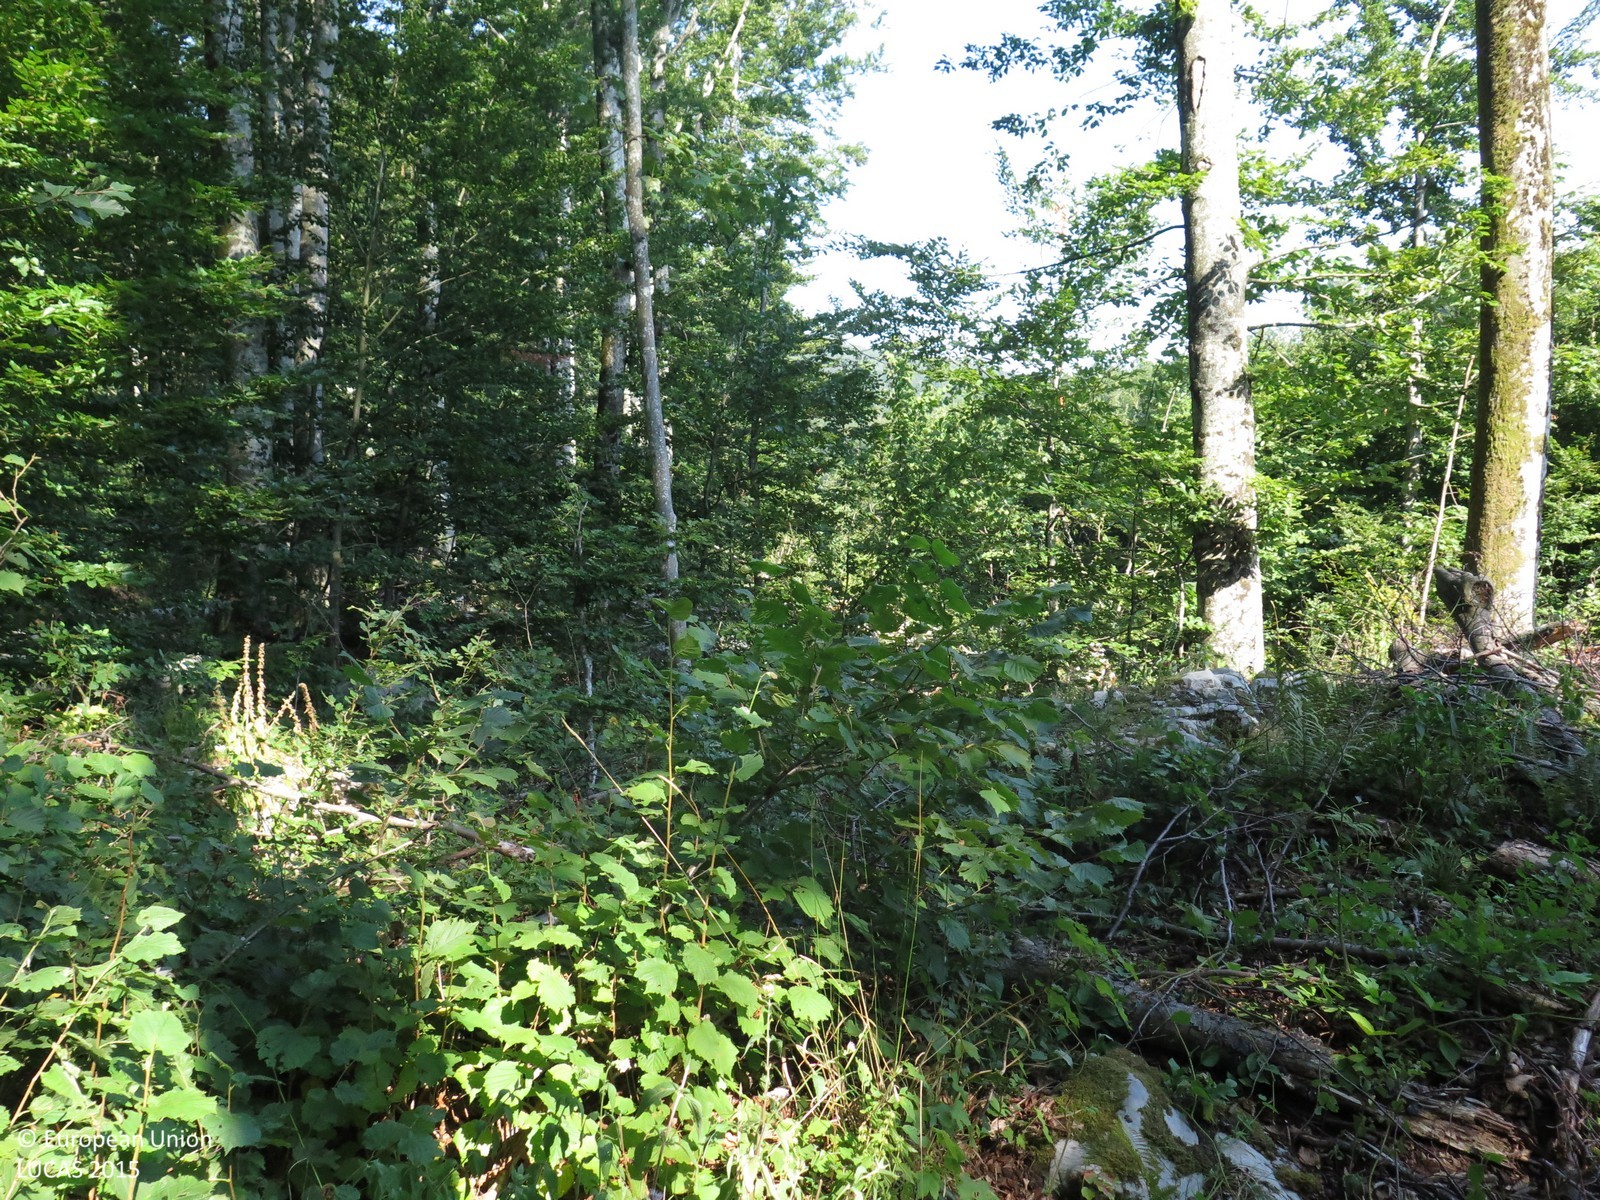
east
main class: Woodland
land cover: Broadleaved woodland
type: beech forest
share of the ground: > 75 %
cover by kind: broadleaved forest trees 90 %, shrubs 5 %, herbaceous plants 5 %
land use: Forestry
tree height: > 5 m
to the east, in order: Broadleaved woodland
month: August
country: HR
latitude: 45.3791
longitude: 15.1419
